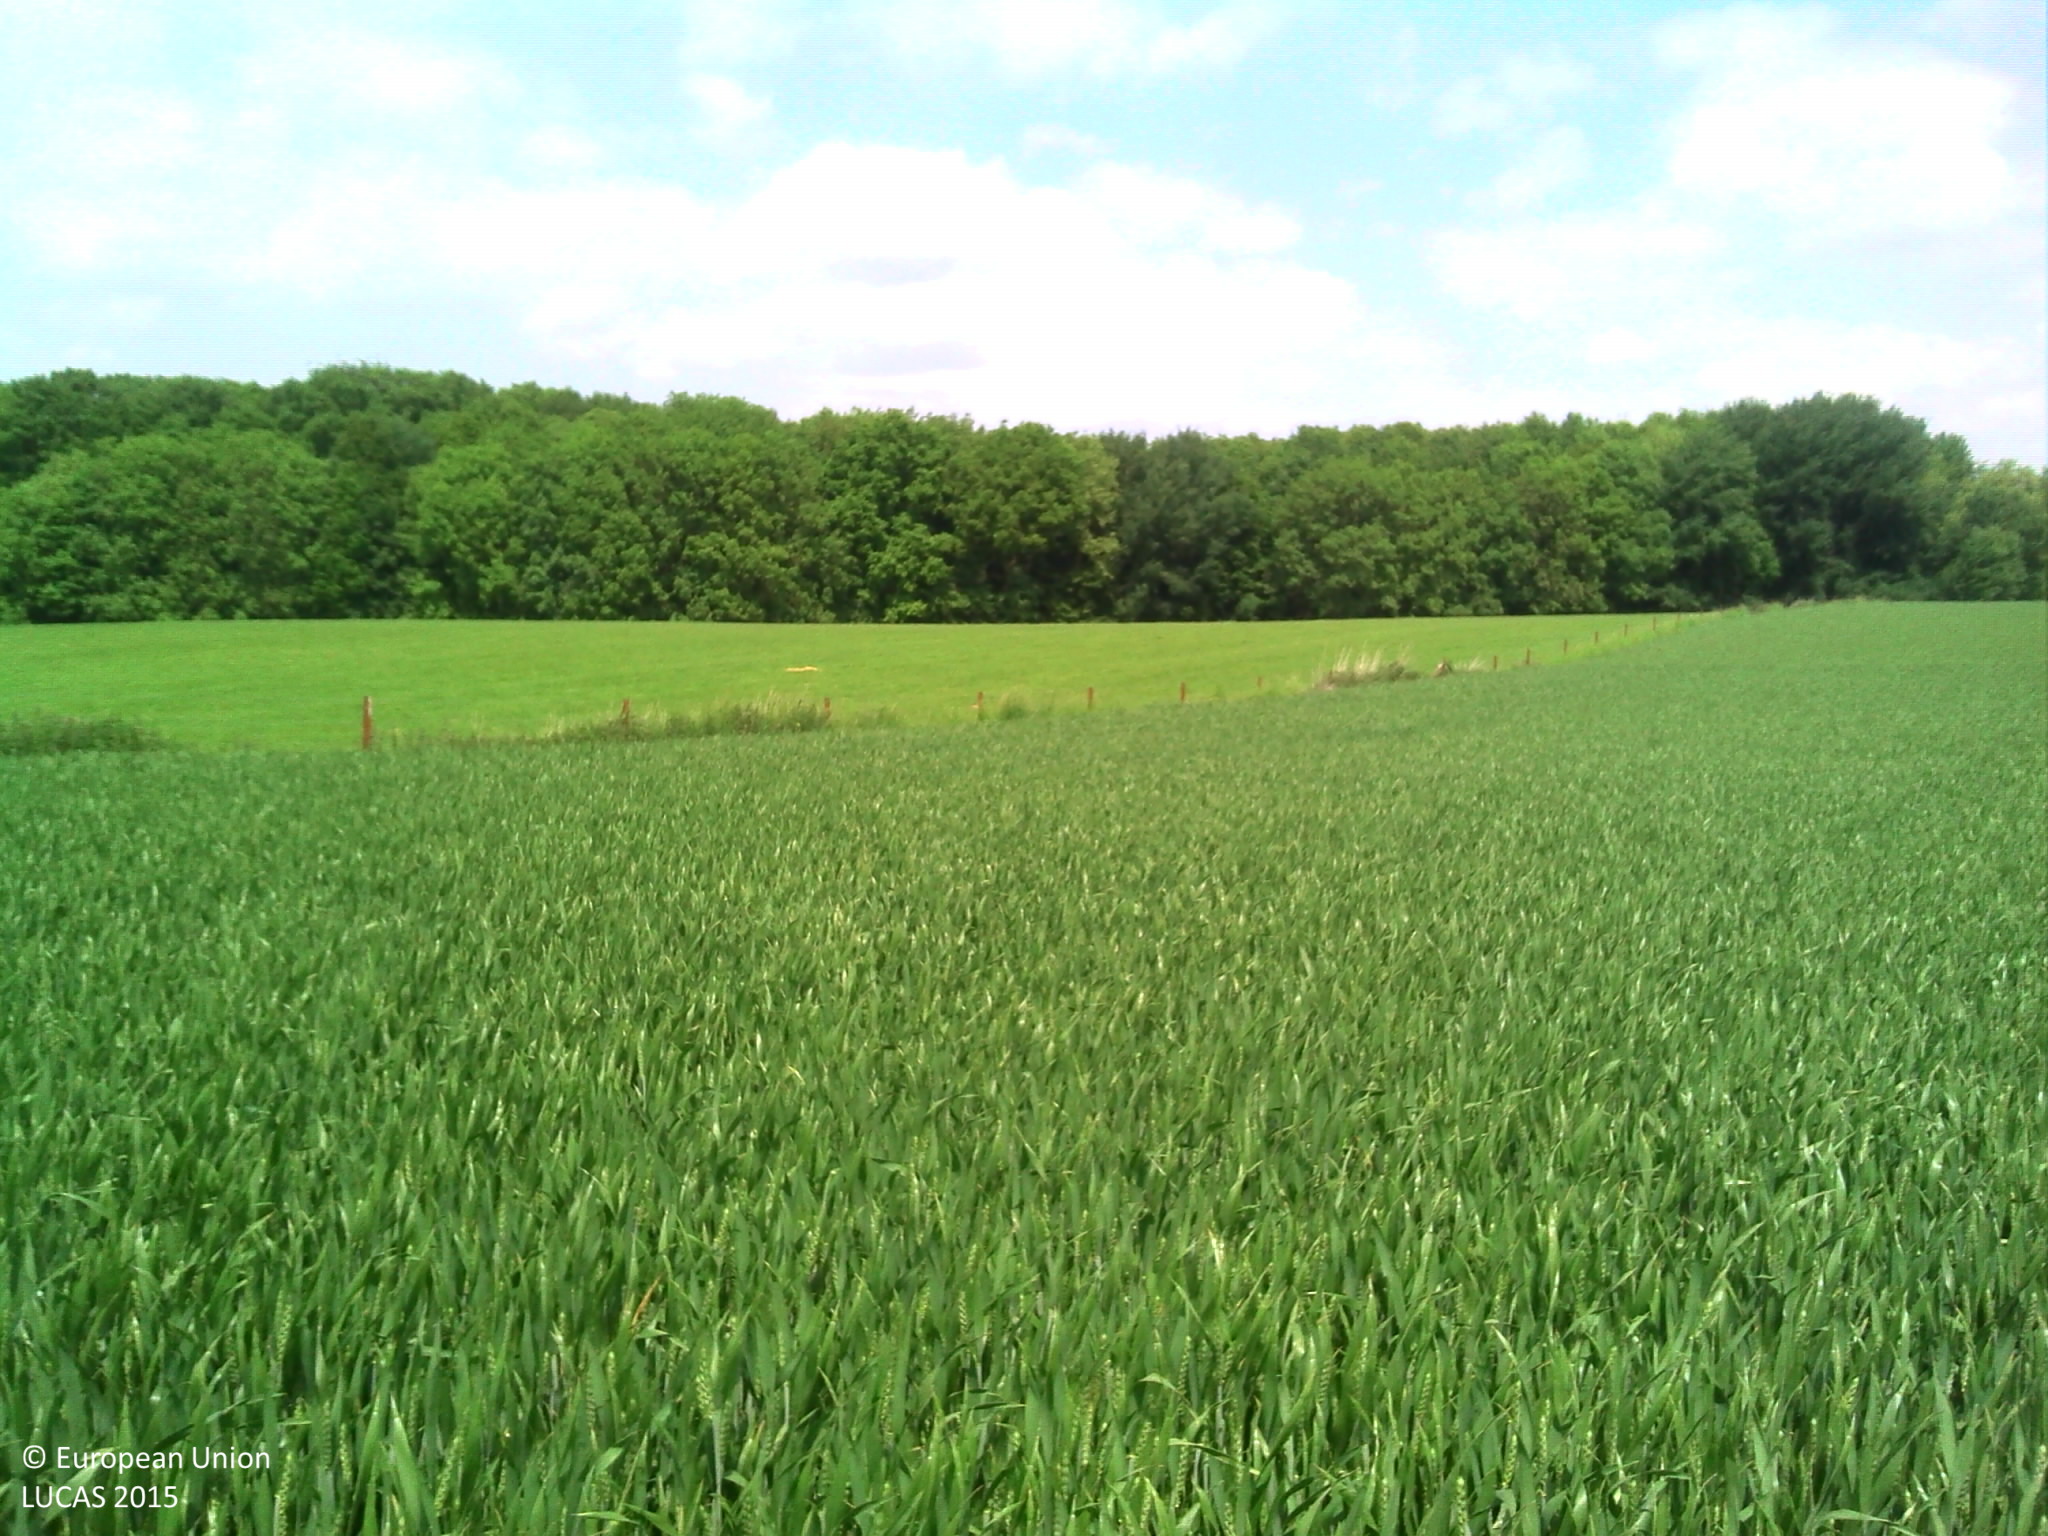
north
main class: Cropland
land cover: Common wheat
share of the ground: > 75 %
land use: Agriculture (excluding fallow land and kitchen gardens)
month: May
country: BE
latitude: 50.6142
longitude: 4.5833
